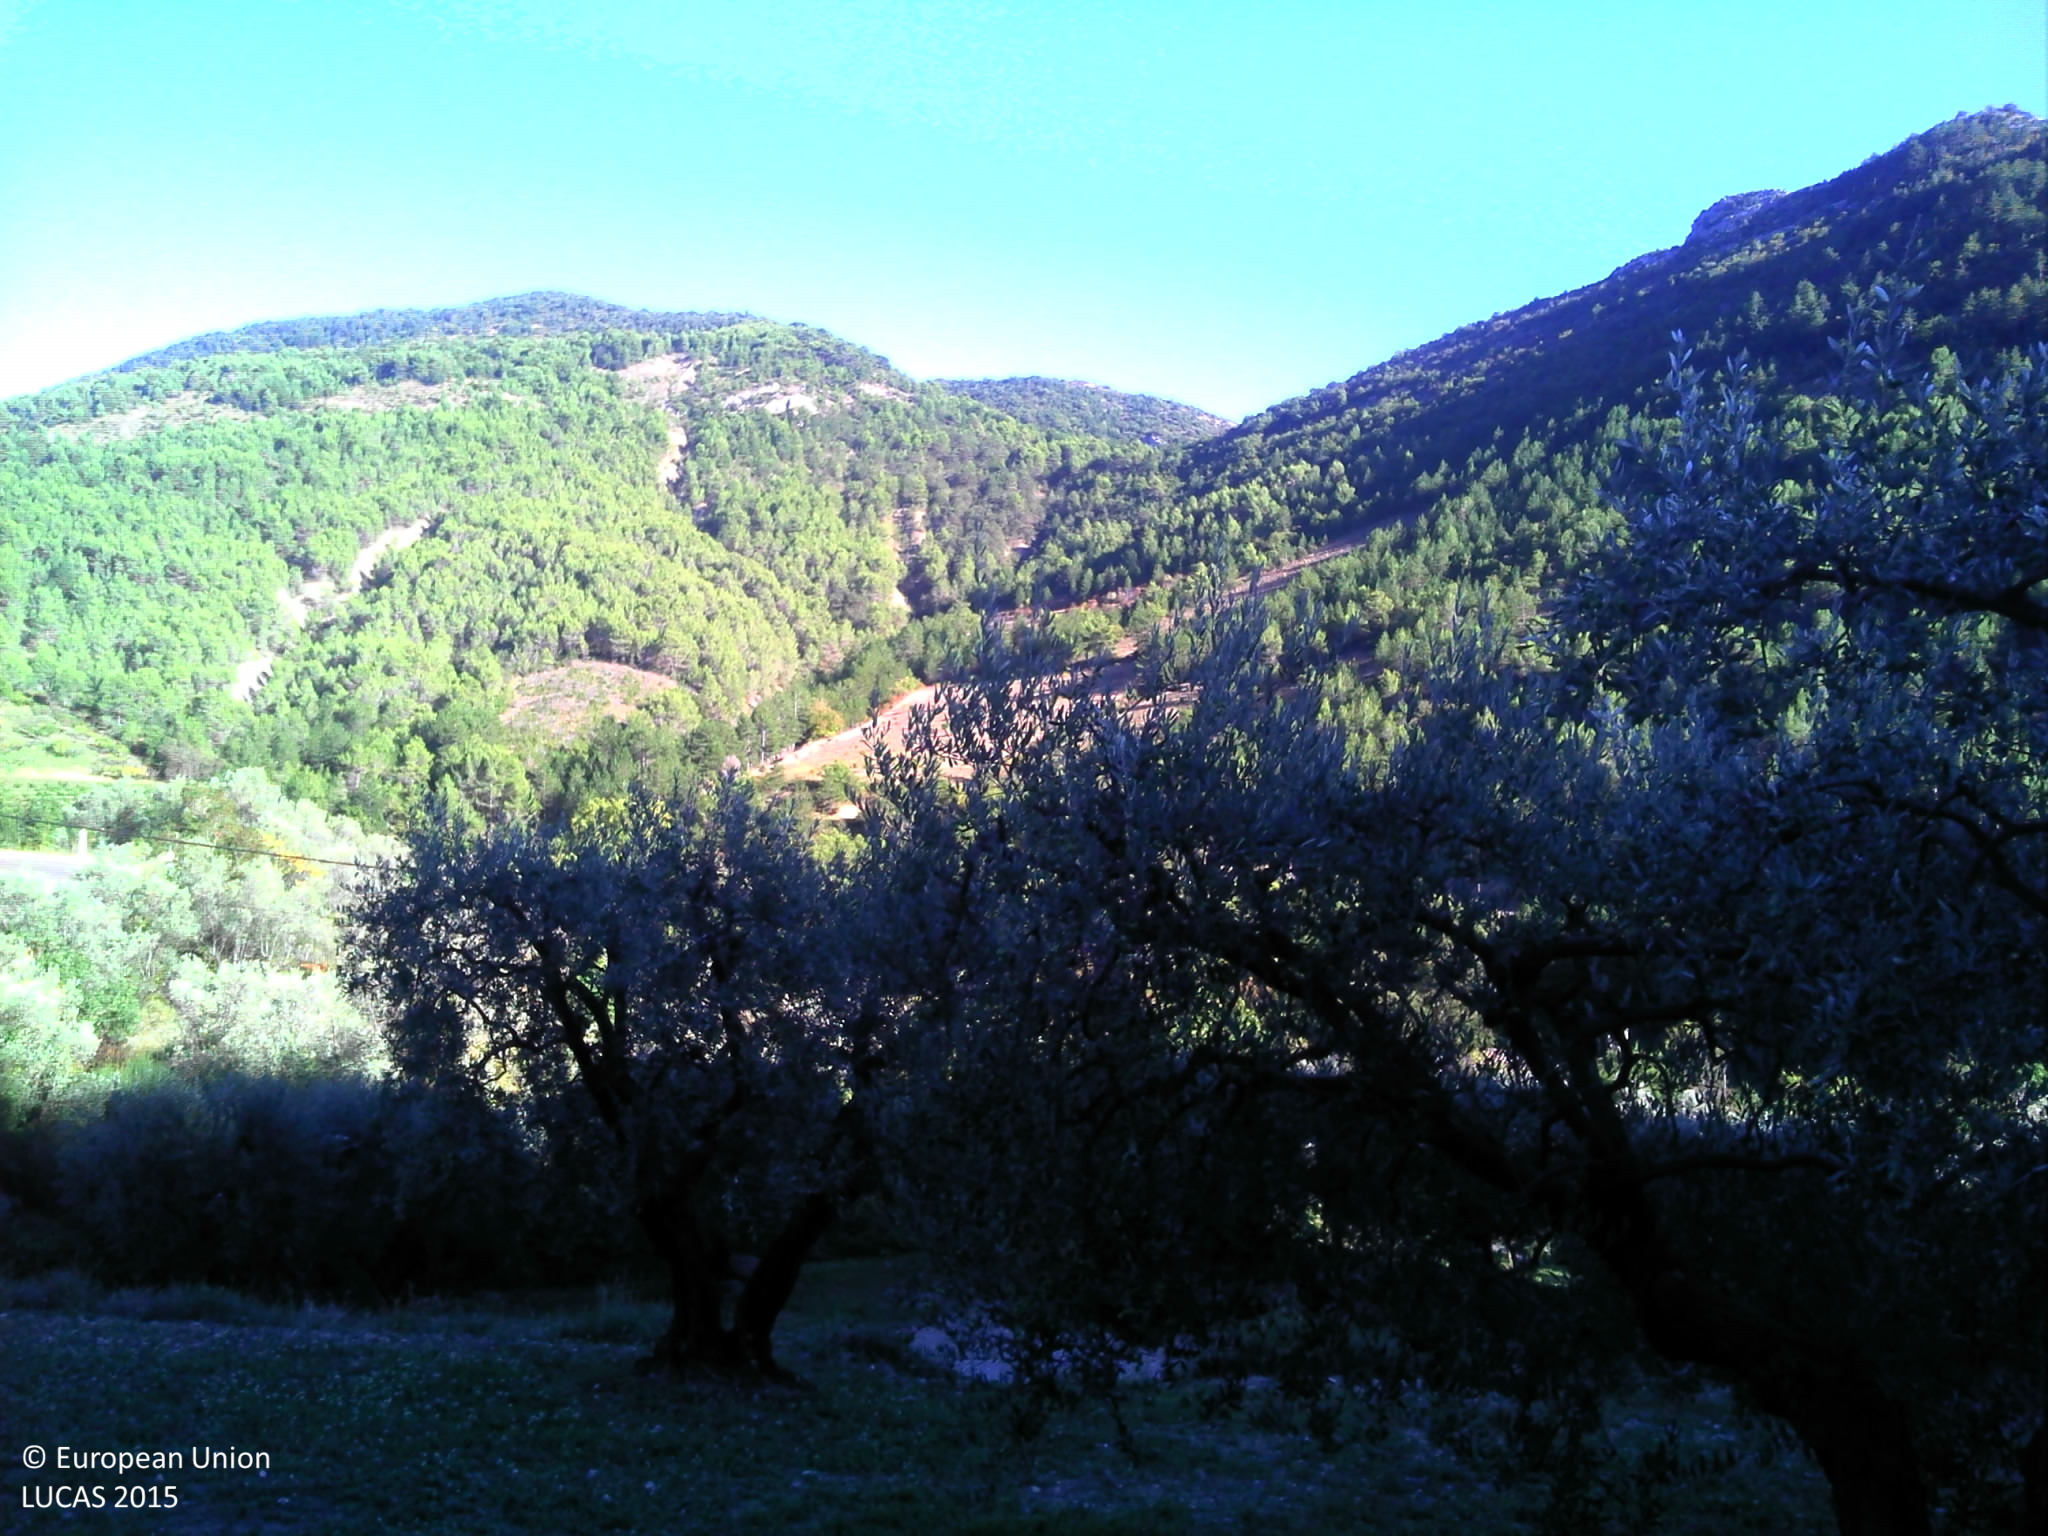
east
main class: Cropland
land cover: Olive groves
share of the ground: > 75 %
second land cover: Rocks and stones
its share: > 75 %
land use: Agriculture (excluding fallow land and kitchen gardens)
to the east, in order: Olive groves; Rocks and stones; Ditches and canals; Paved roads, cycling and walking lanes; Electric lines; Ditches and canals; Olive groves; Artificial constructions in urban areas; Ditches and canals; Paved roads, cycling and walking lanes; Shrubland with sparse tree cover; Ditches and canals; Paved roads, cycling and walking lanes; Ditches and canals; Grass margins; Shrubland with sparse tree cover; Rocks and stones; Broadleaved woodland; Dry stone walls; Fences; Grassland without tree/shrub cover
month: September
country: FR
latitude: 44.2975
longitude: 5.2824
